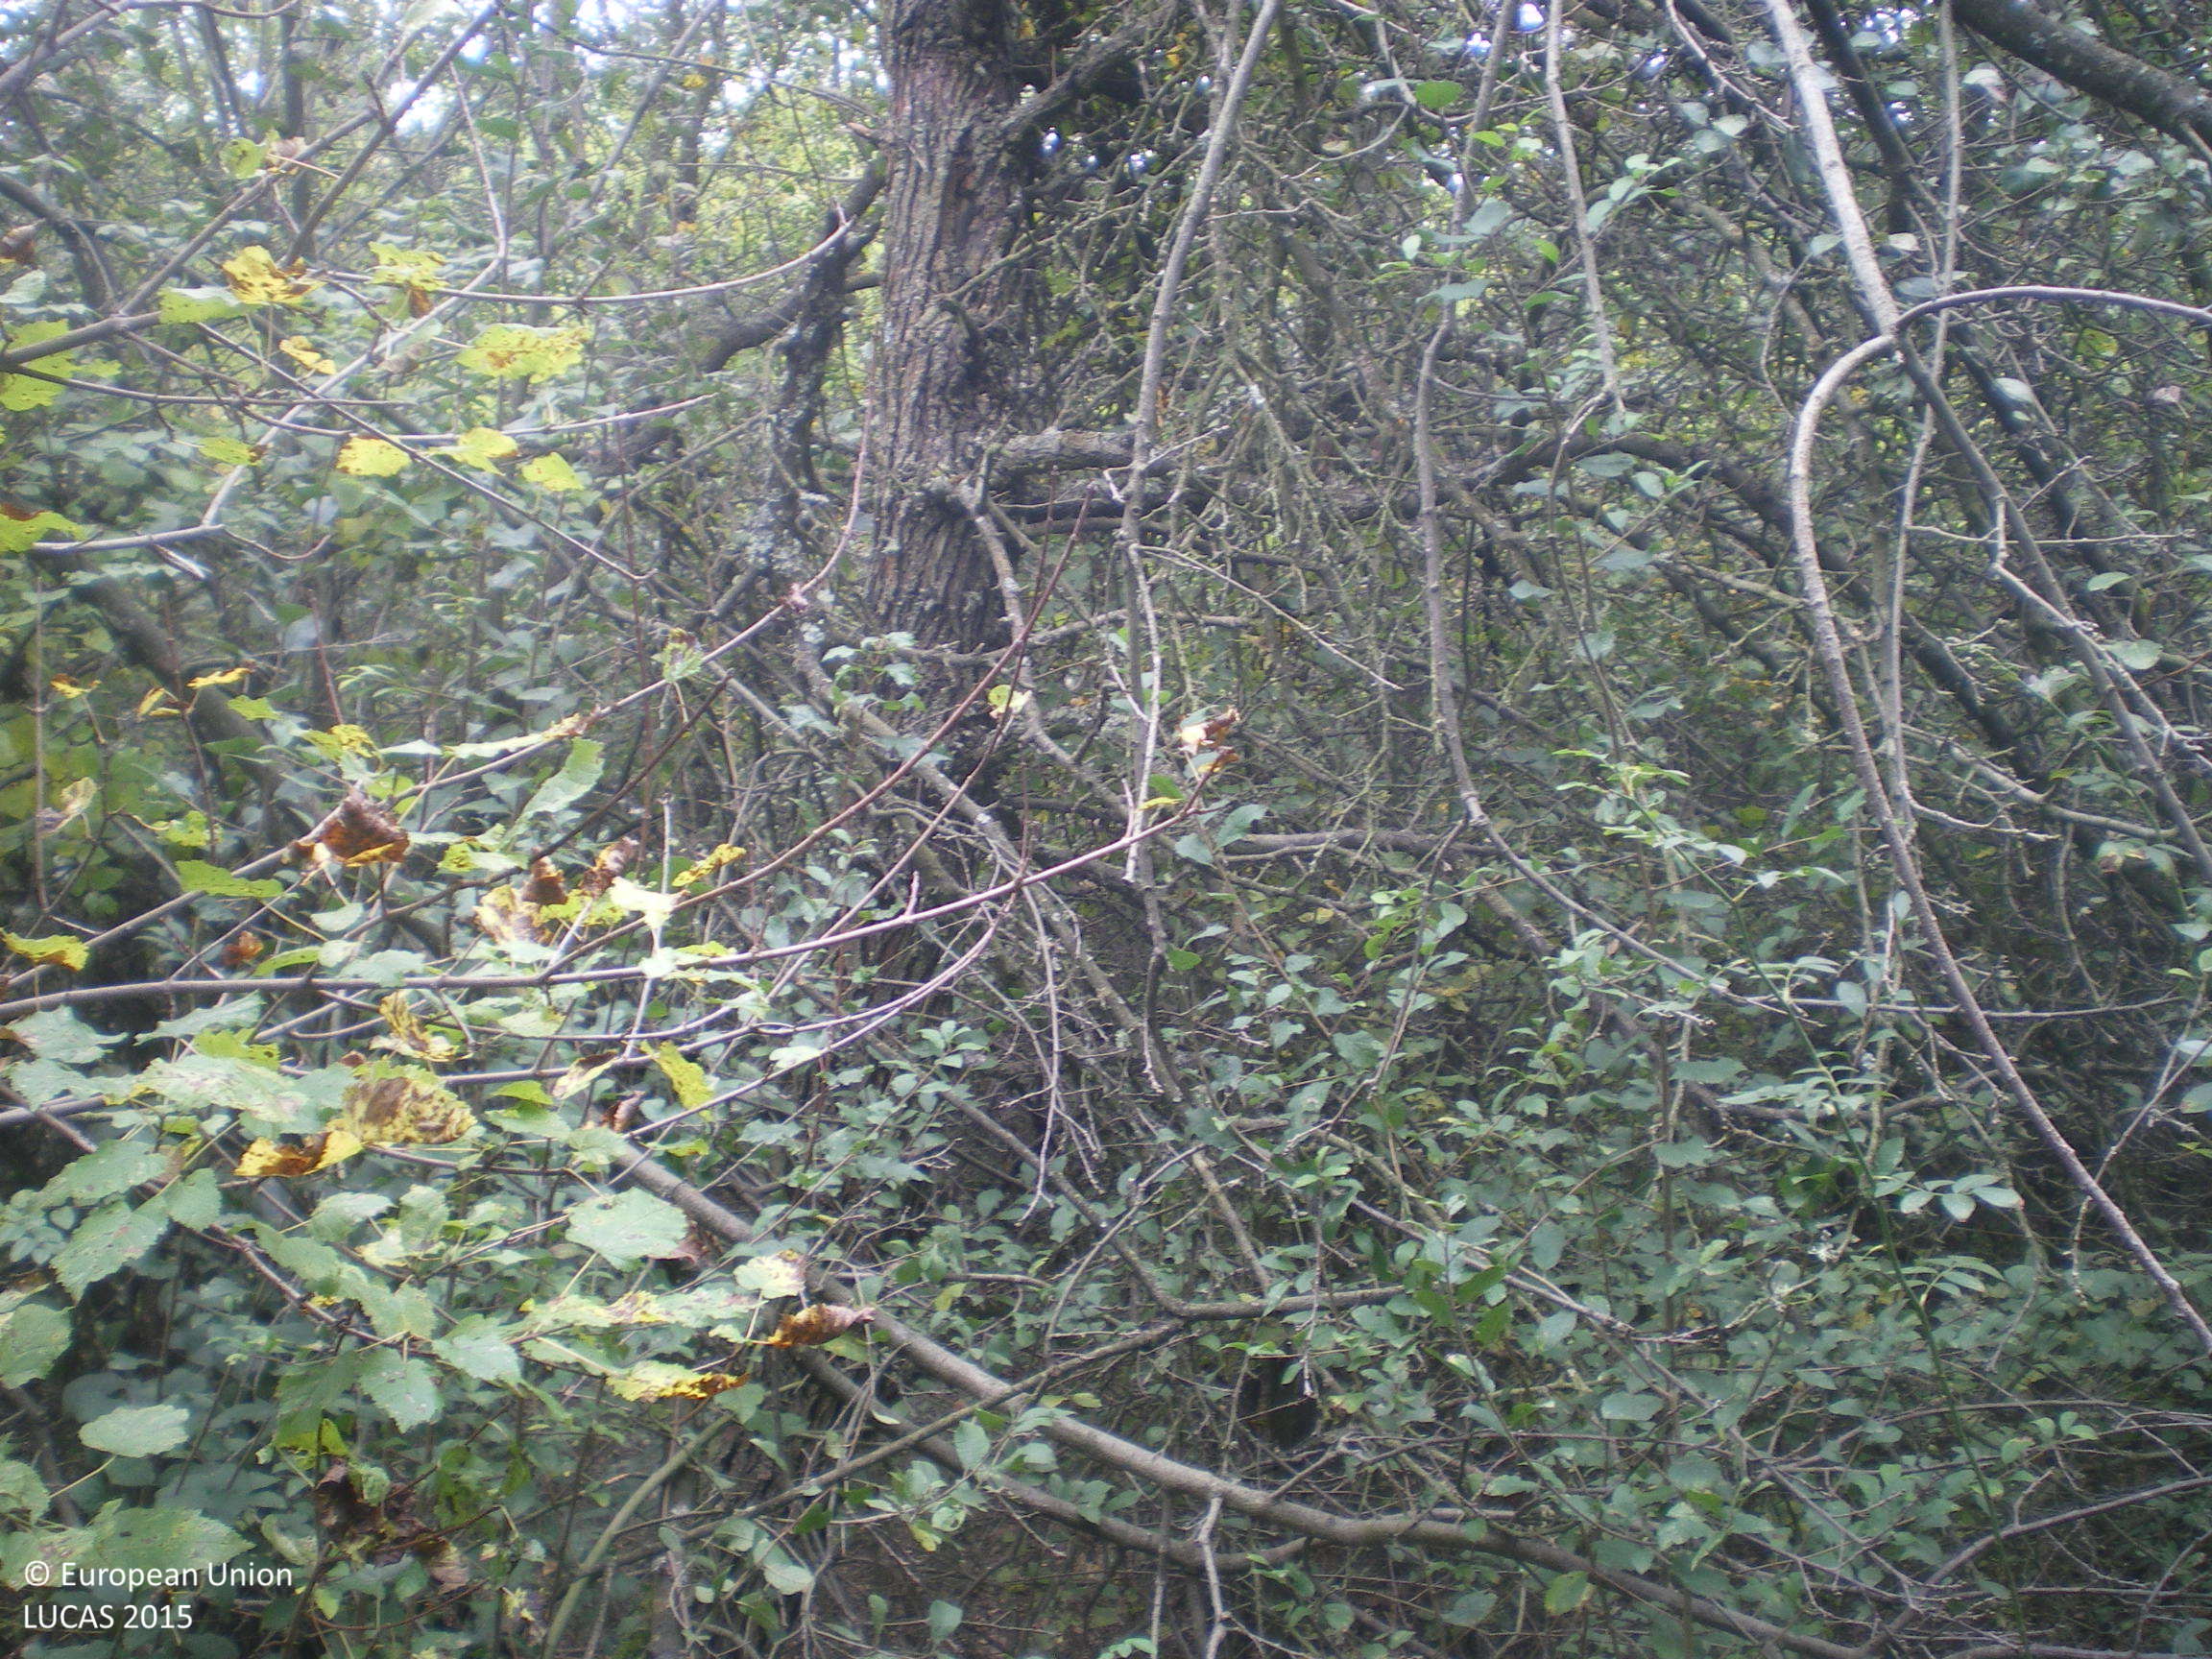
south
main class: Woodland
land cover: Broadleaved woodland
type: mesophytic deciduous forest
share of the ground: > 75 %
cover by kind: broadleaved forest trees 95 %, unconsolidated bare surface 5 %
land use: Forestry
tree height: > 5 m
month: October
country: BG
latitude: 42.0531
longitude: 25.7657
